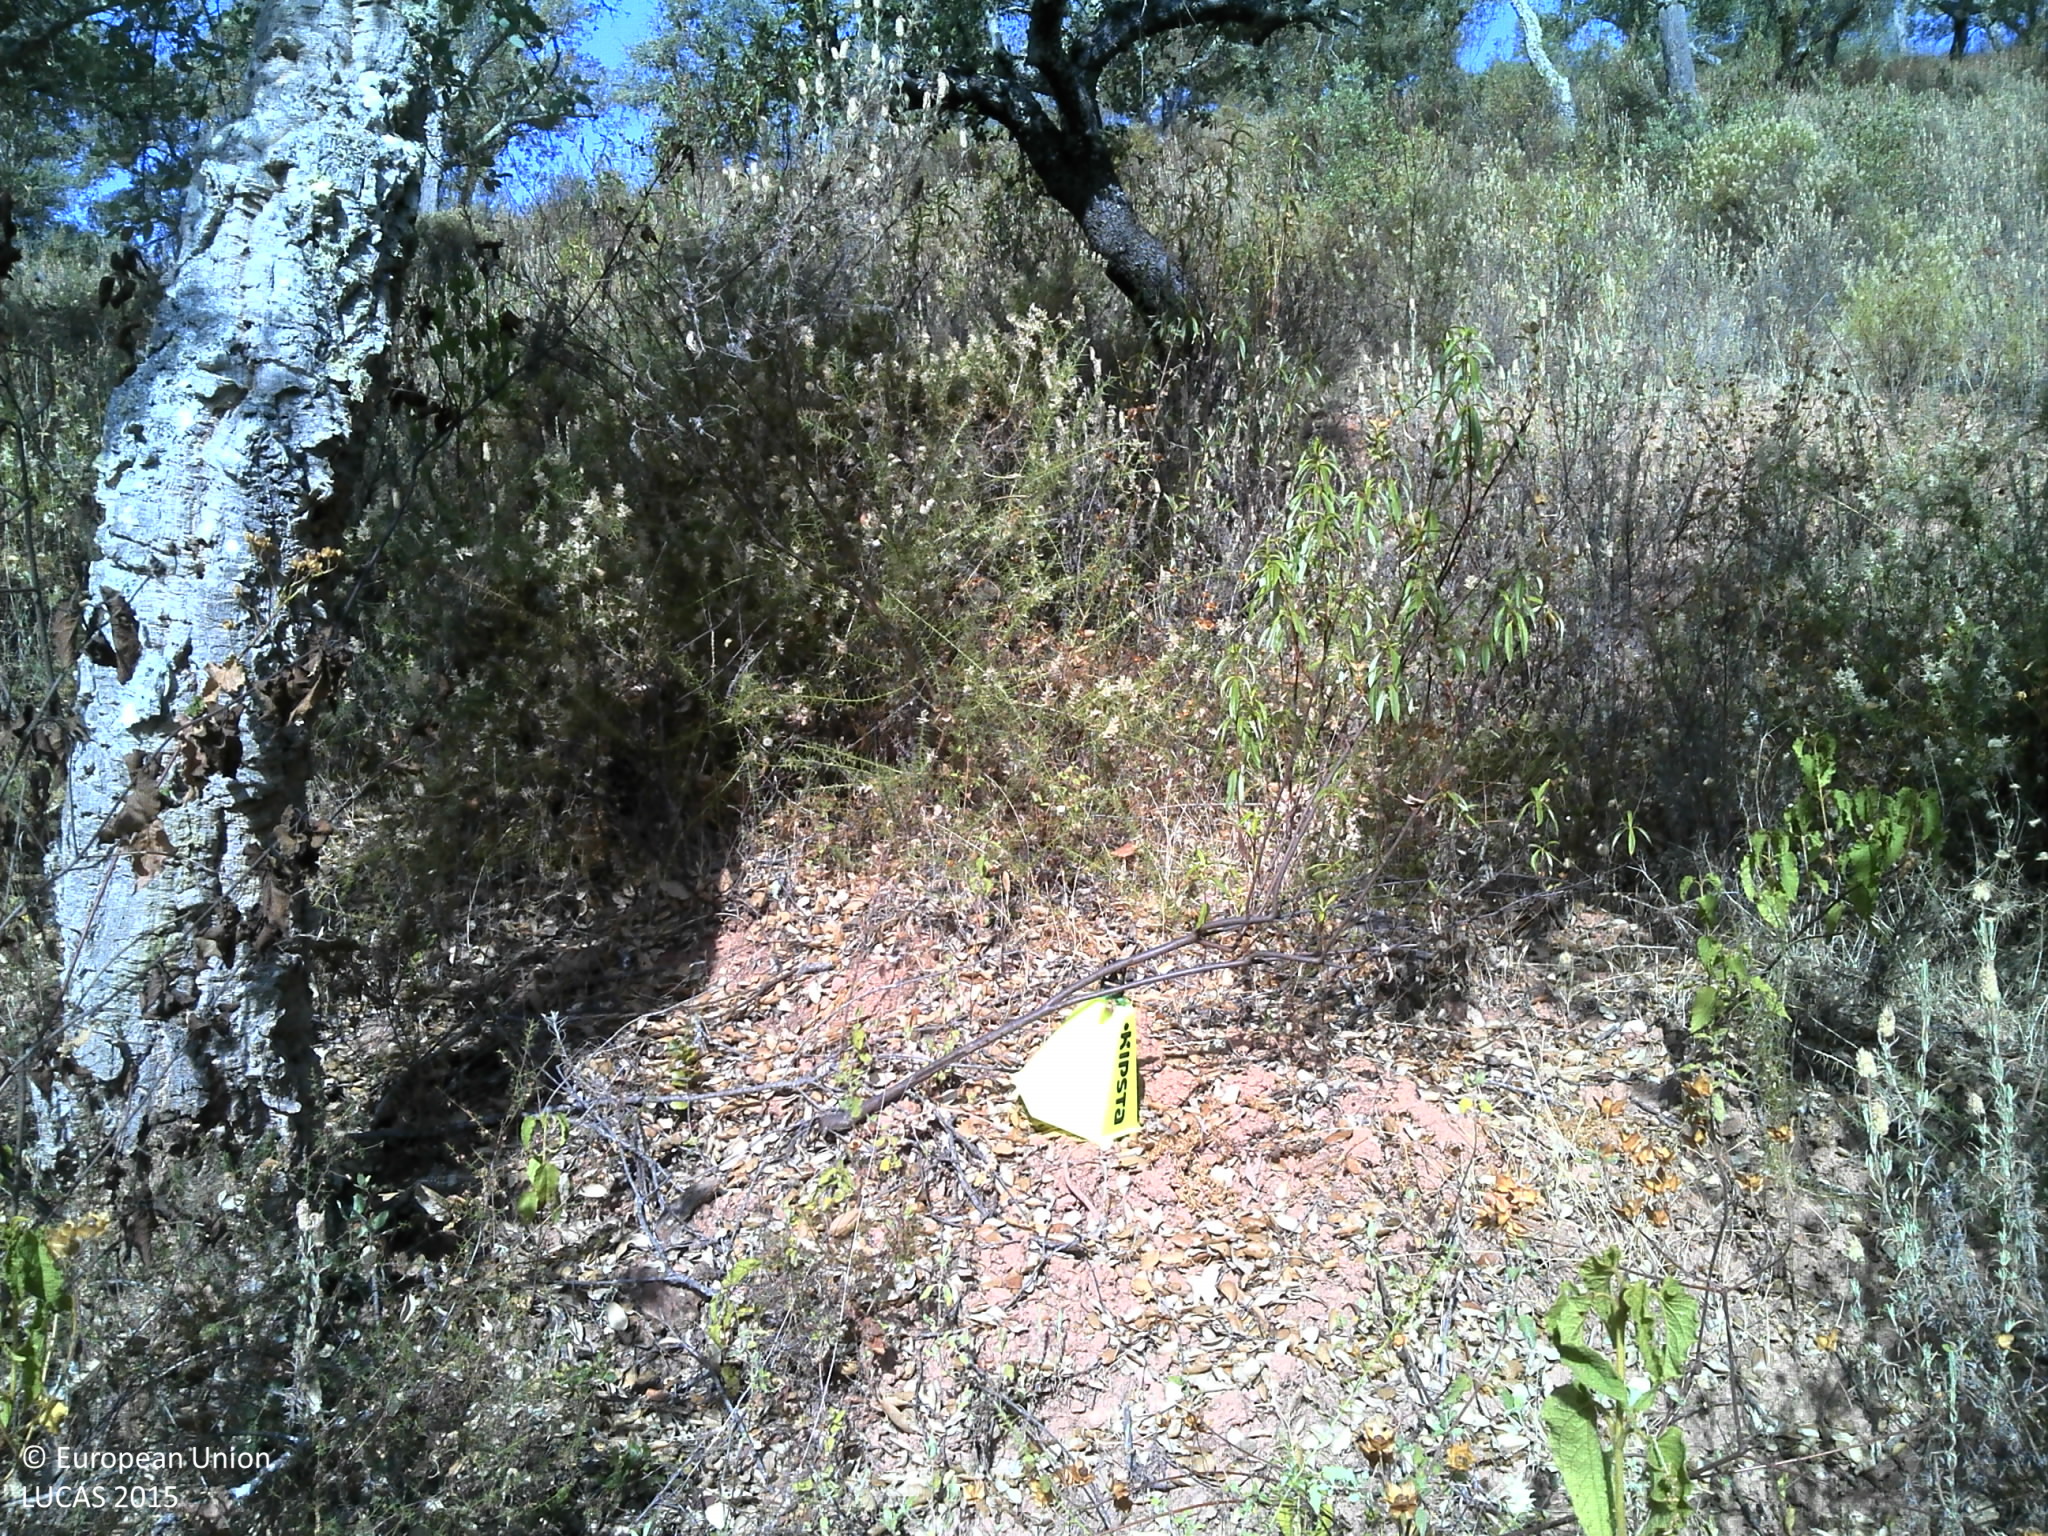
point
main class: Woodland
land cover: Broadleaved woodland
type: broadleaved evergreen forest
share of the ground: 50 - 75 %
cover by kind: broadleaved forest trees 50 %, shrubs 50 %
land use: Forestry
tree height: > 5 m
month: July
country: PT
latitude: 38.3504
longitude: -7.6861
